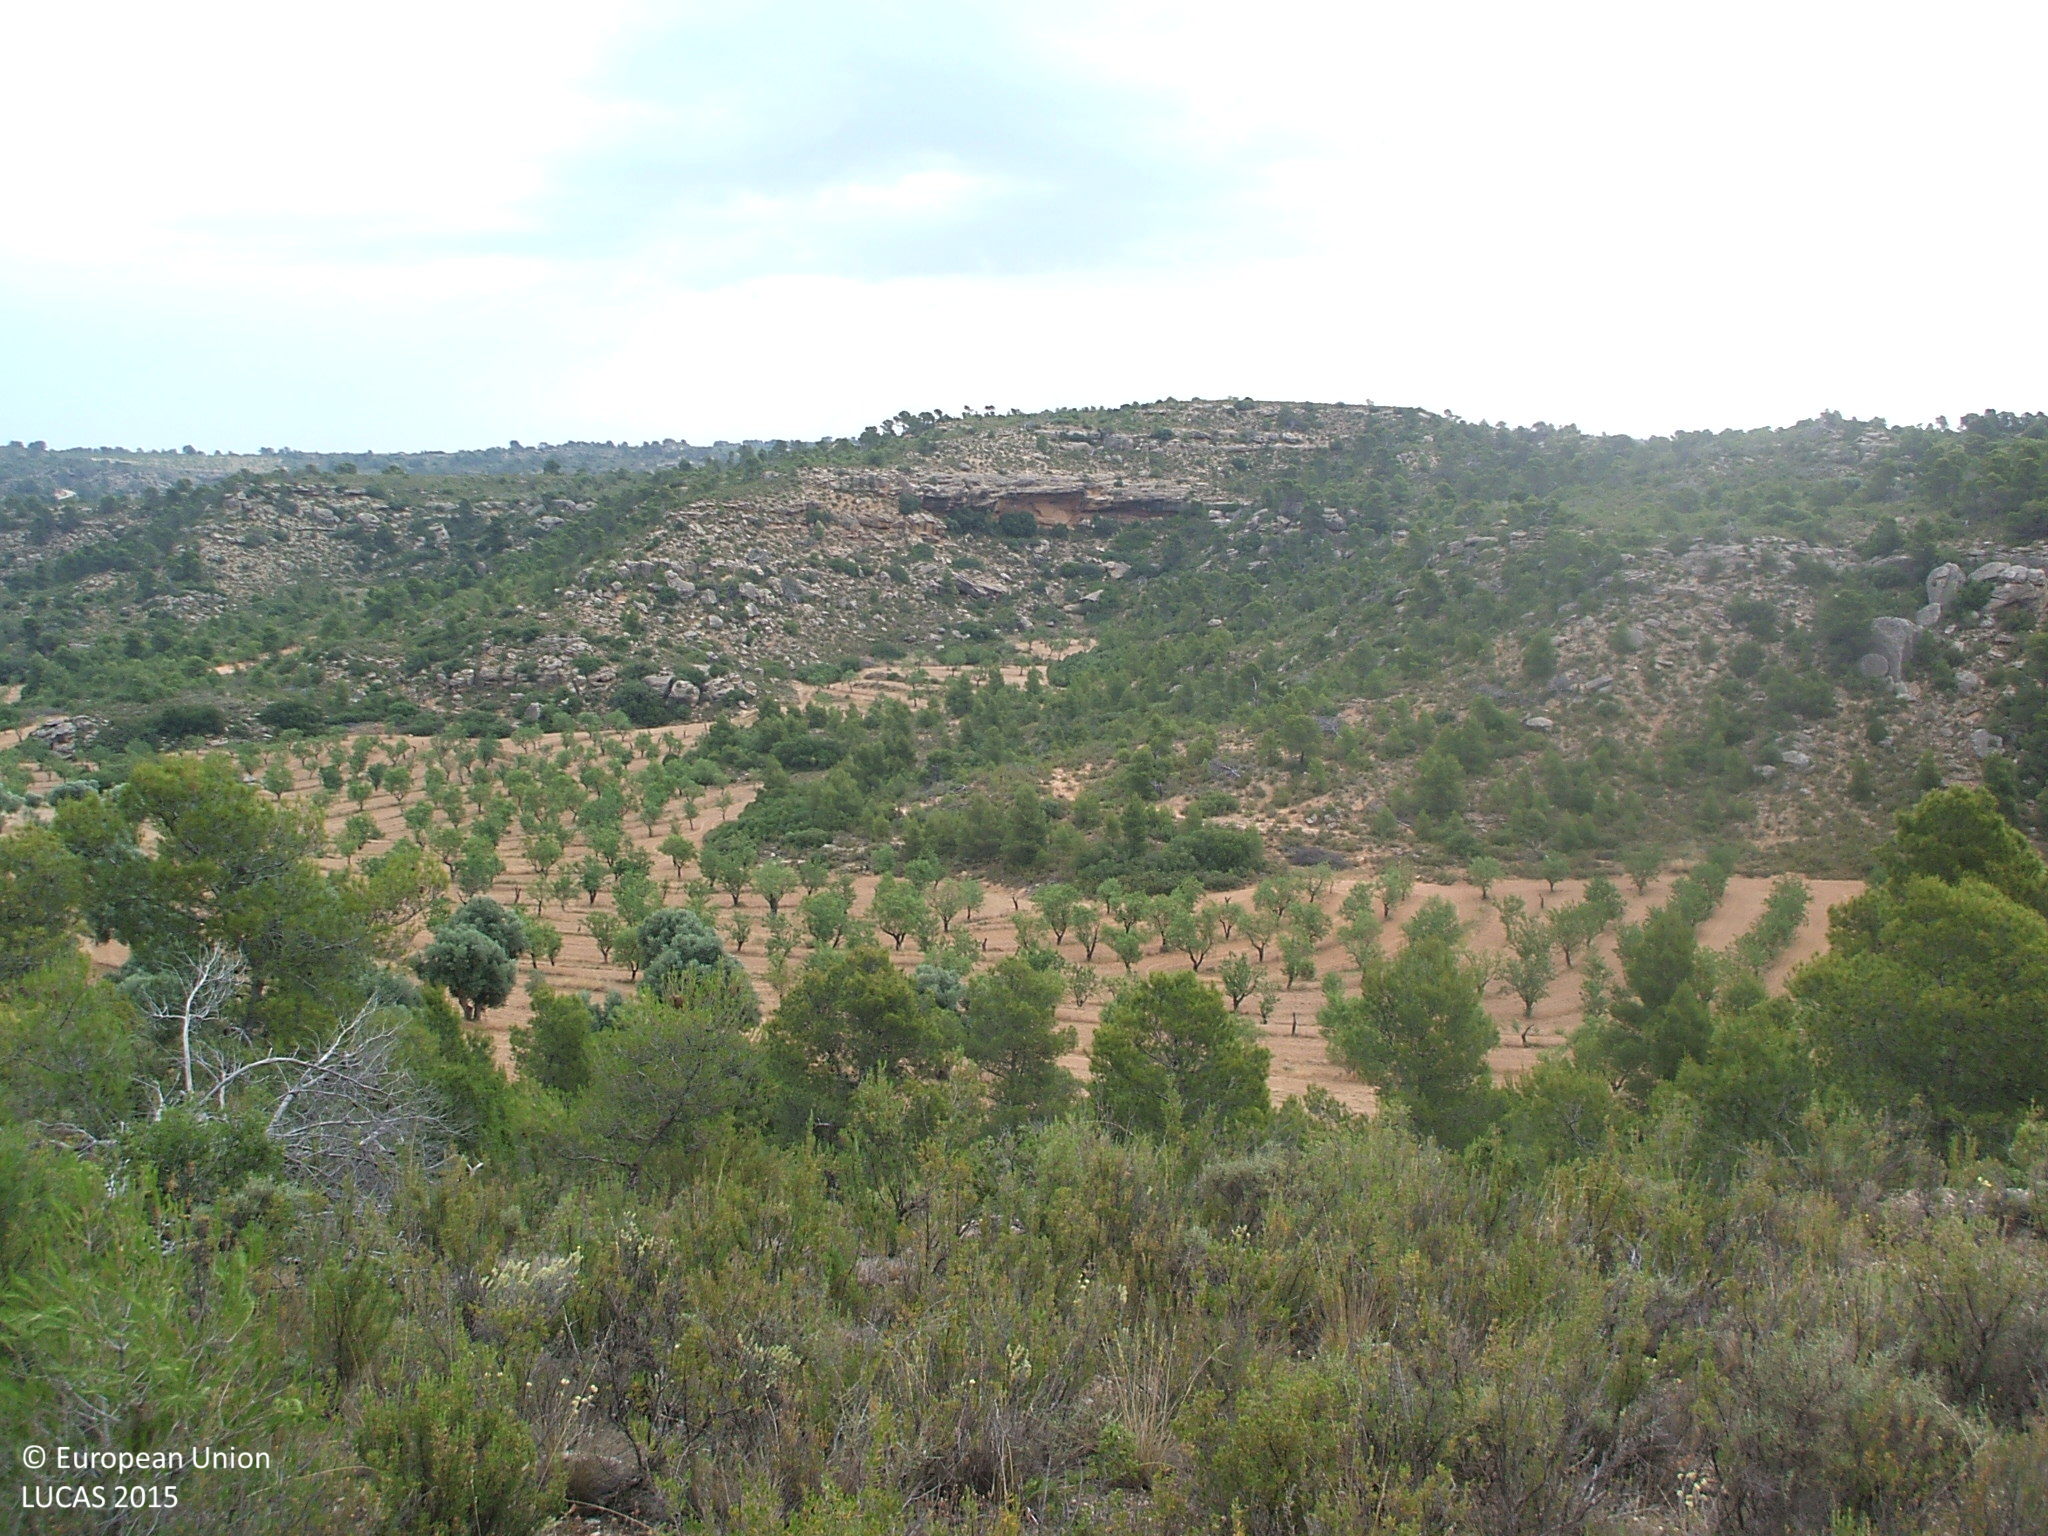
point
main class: Shrubland
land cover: Shrubland with sparse tree cover
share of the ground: > 75 %
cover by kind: shrubs 95 %, coniferous forest trees 5 %
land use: Semi-natural and natural areas not in use
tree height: > 5 m
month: June
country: ES
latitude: 41.0239
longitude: -0.0602
